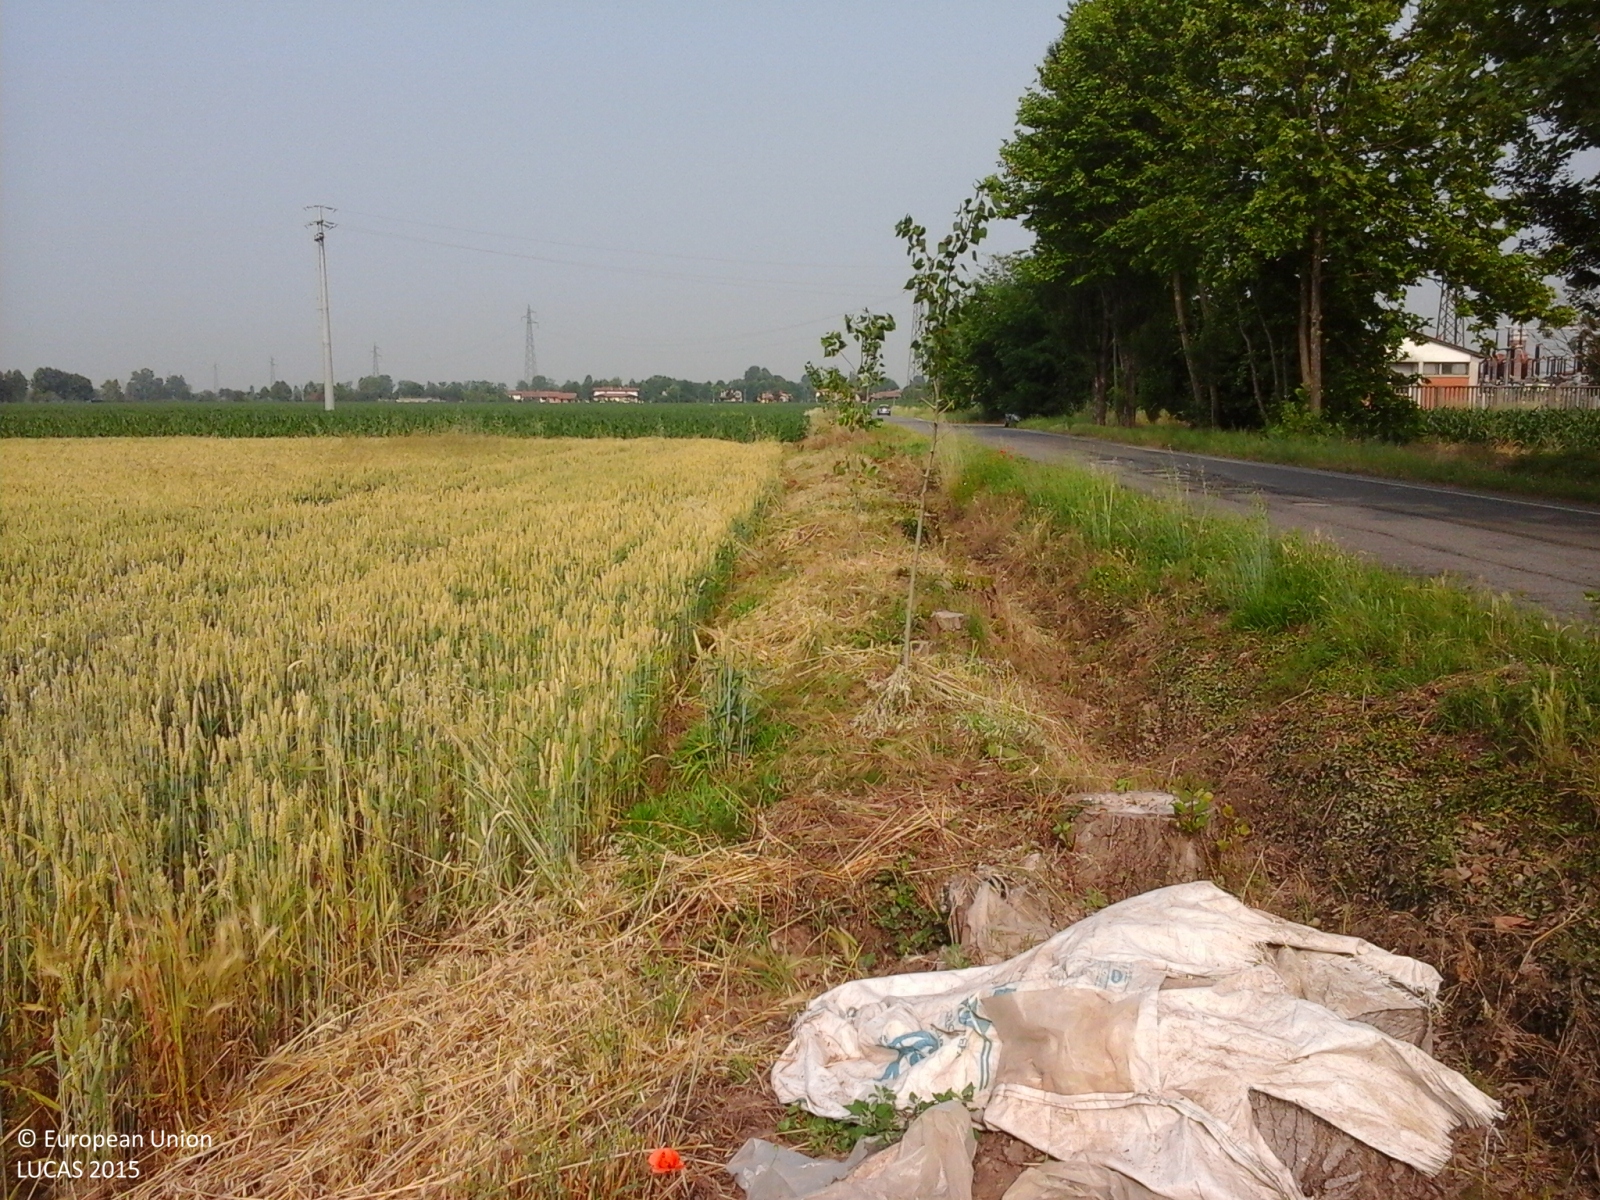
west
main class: Cropland
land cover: Common wheat
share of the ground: > 75 %
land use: Agriculture (excluding fallow land and kitchen gardens)
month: June
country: IT
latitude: 45.4503
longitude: 10.0638
